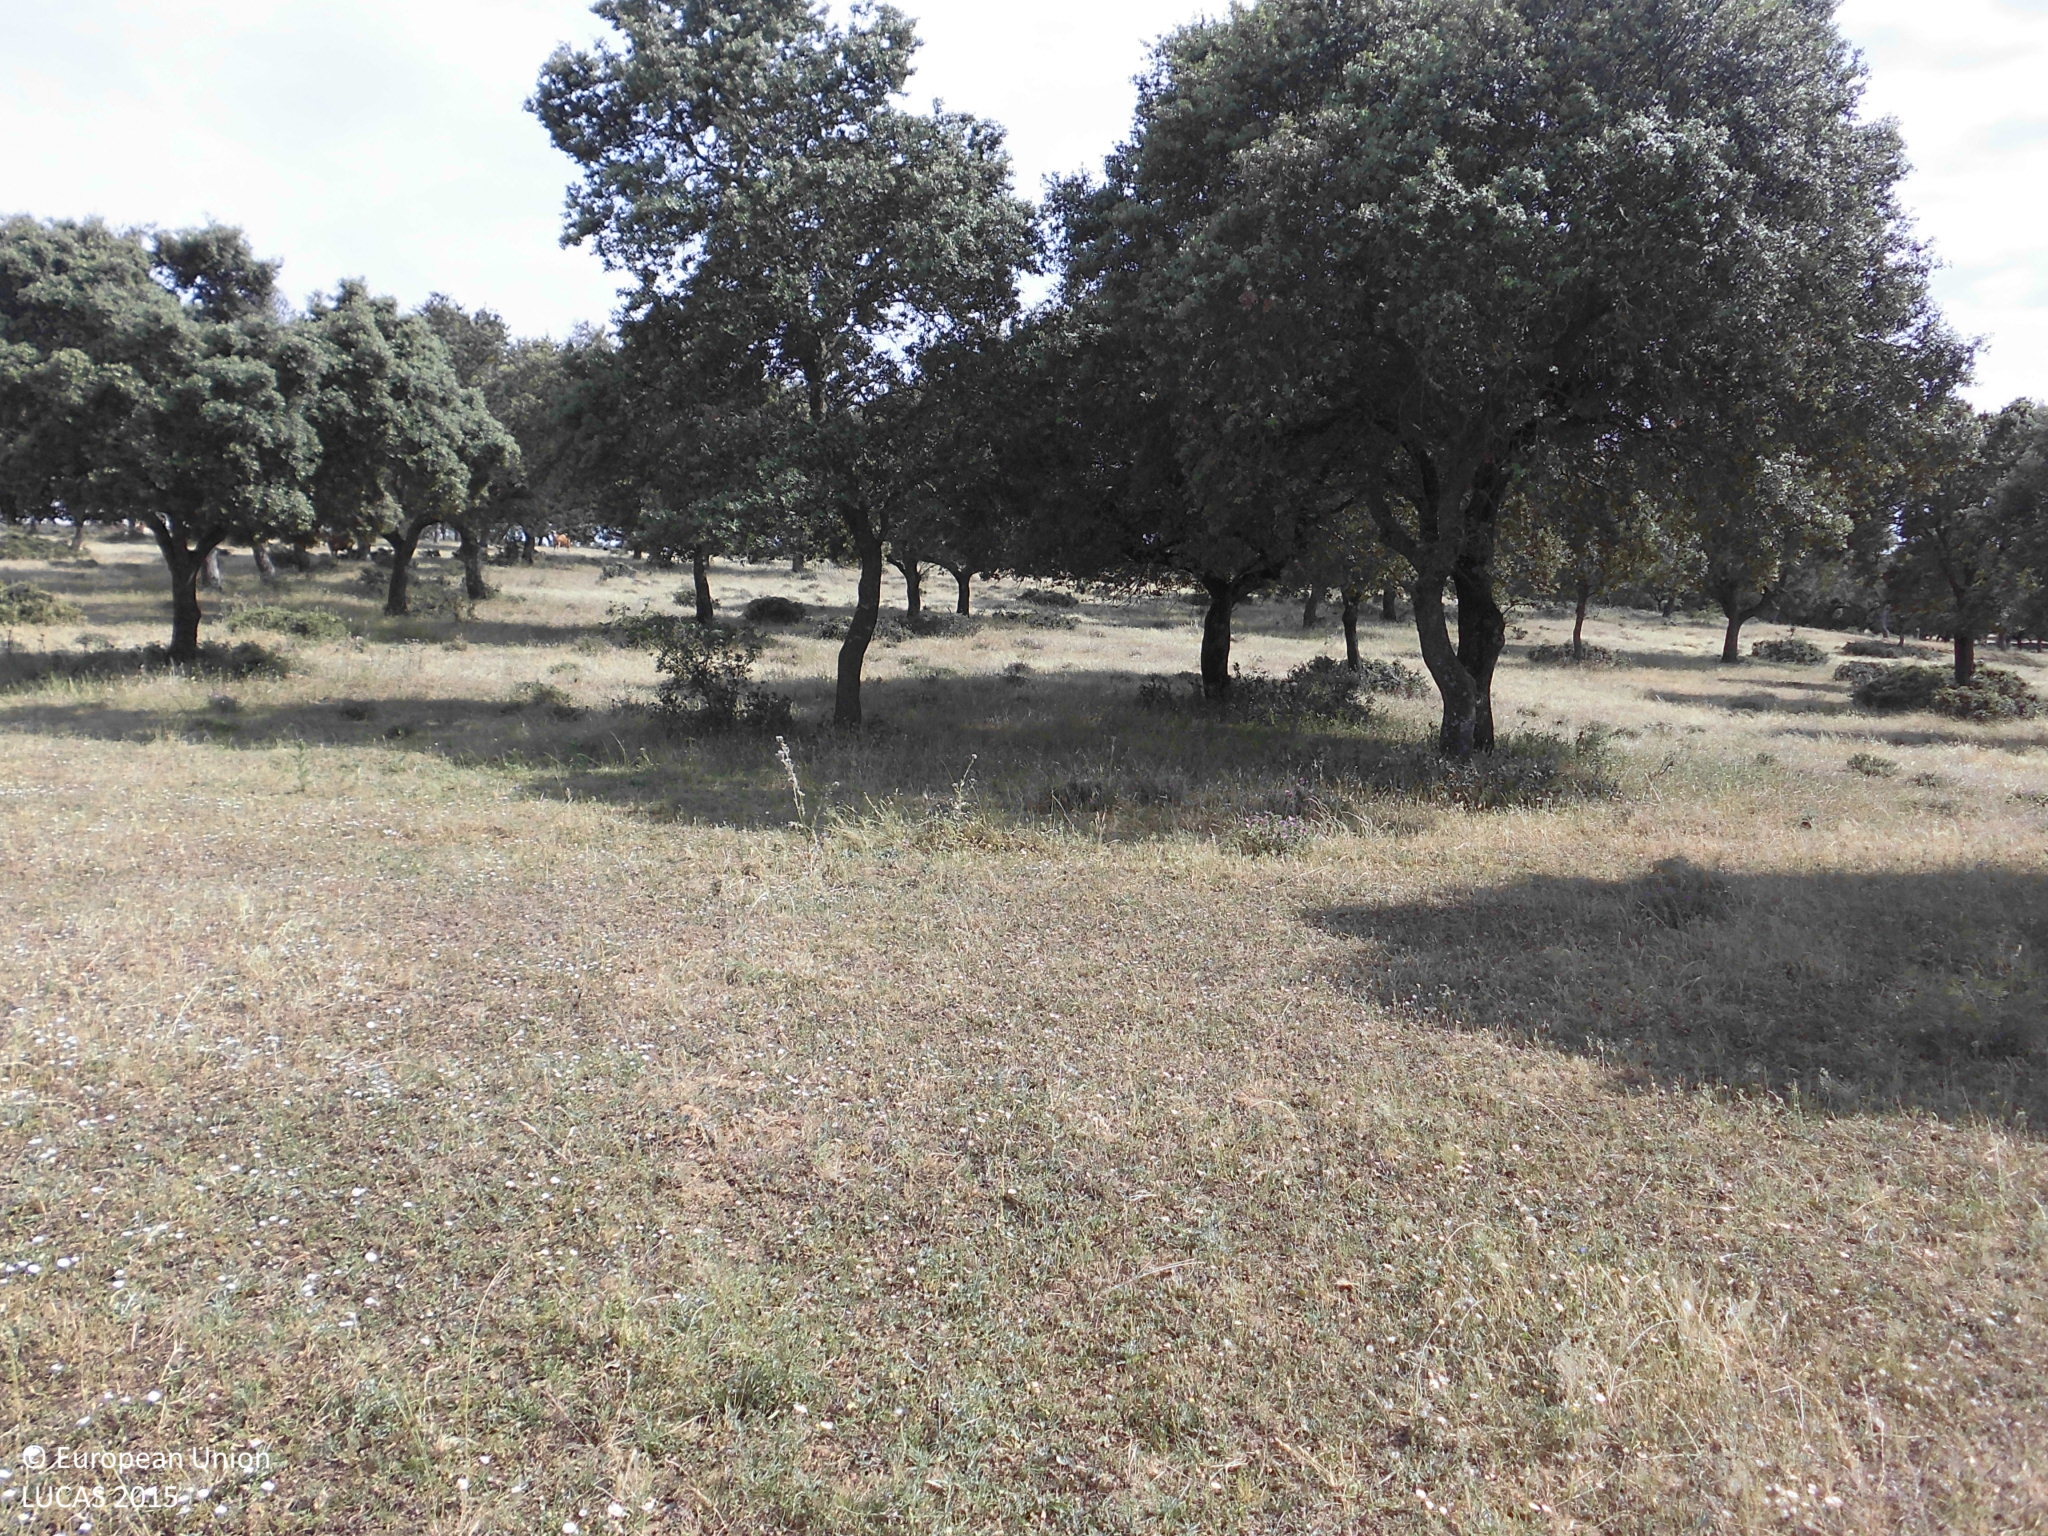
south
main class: Woodland
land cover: Broadleaved woodland
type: broadleaved evergreen forest
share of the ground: 10 - 25 %
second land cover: Grassland without tree/shrub cover
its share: > 75 %
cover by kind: herbaceous plants 75 %, broadleaved forest trees 25 %
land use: Forestry
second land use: Agriculture (excluding fallow land and kitchen gardens)
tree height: > 5 m
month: May
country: ES
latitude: 39.6131
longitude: -6.7224
